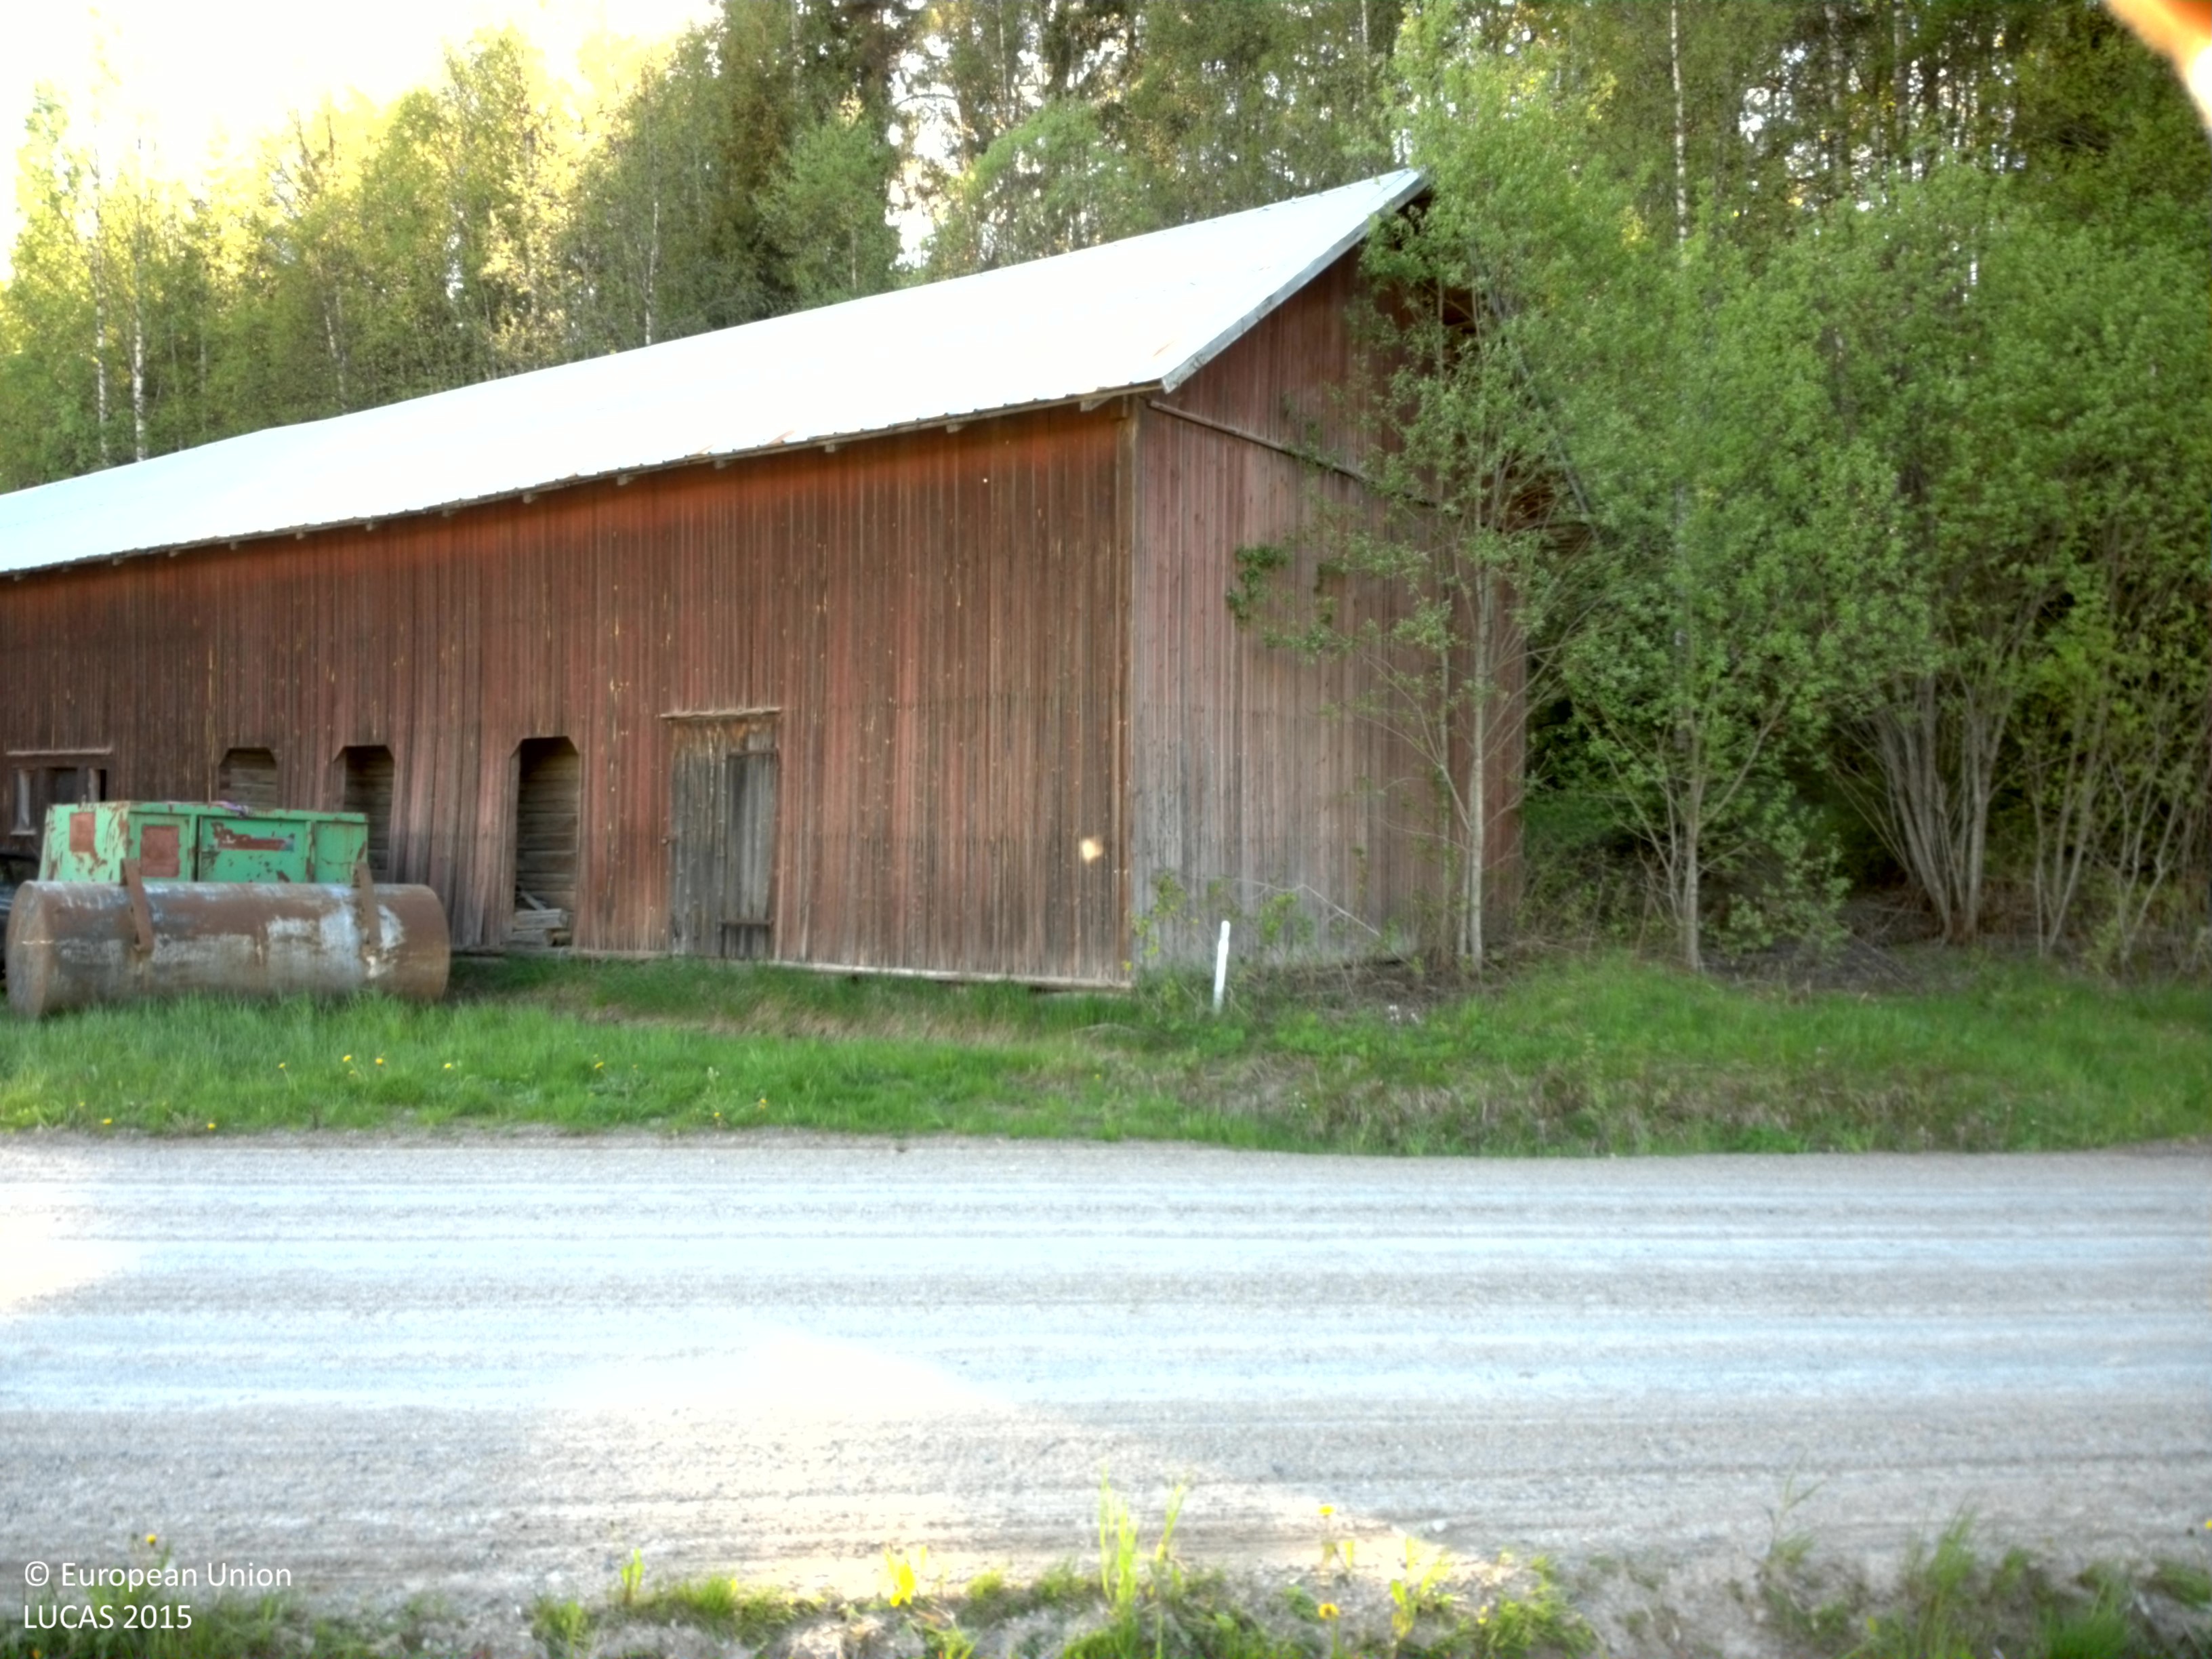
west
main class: Grassland
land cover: Grassland without tree/shrub cover
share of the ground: > 75 %
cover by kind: herbaceous plants 100 %
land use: Agriculture (excluding fallow land and kitchen gardens)
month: June
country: SE
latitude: 60.5428
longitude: 13.1077
